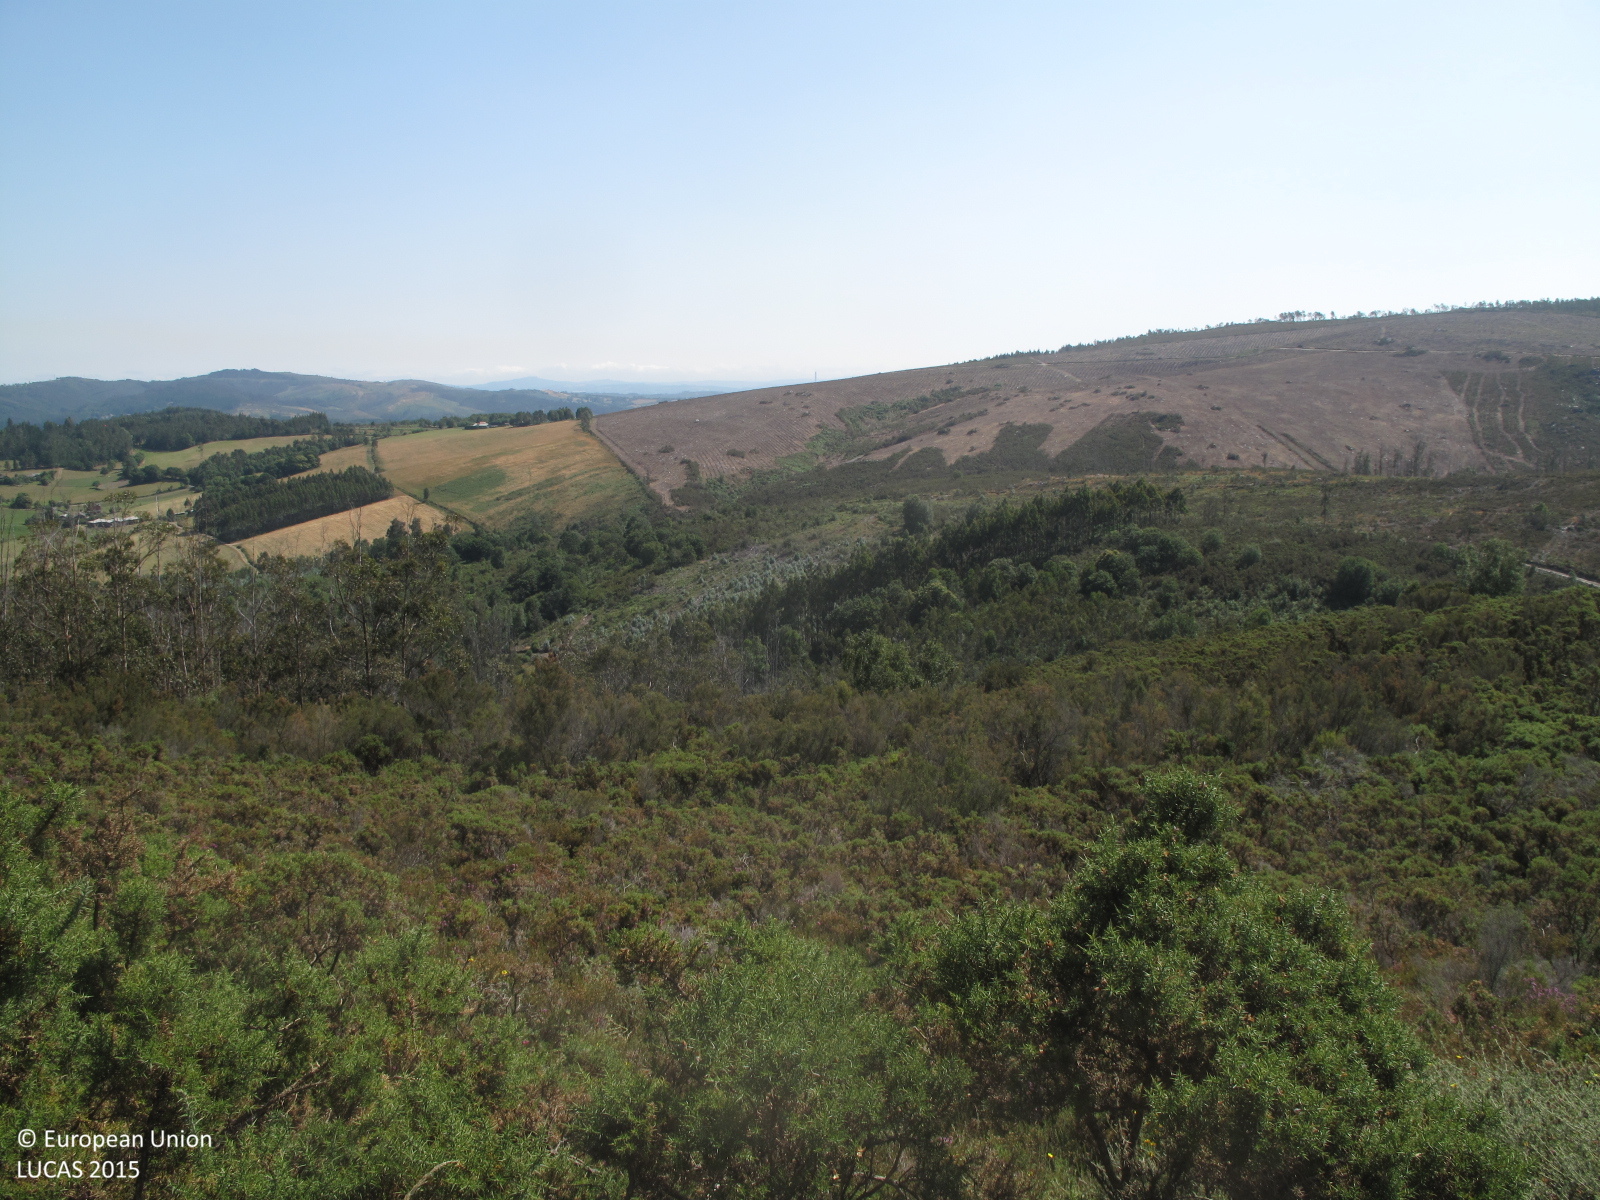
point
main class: Shrubland
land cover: Shrubland with sparse tree cover
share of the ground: > 75 %
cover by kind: shrubs 95 %, broadleaved forest trees 5 %
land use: Abandoned areas
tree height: > 5 m
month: July
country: ES
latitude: 43.3647
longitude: -8.0252
